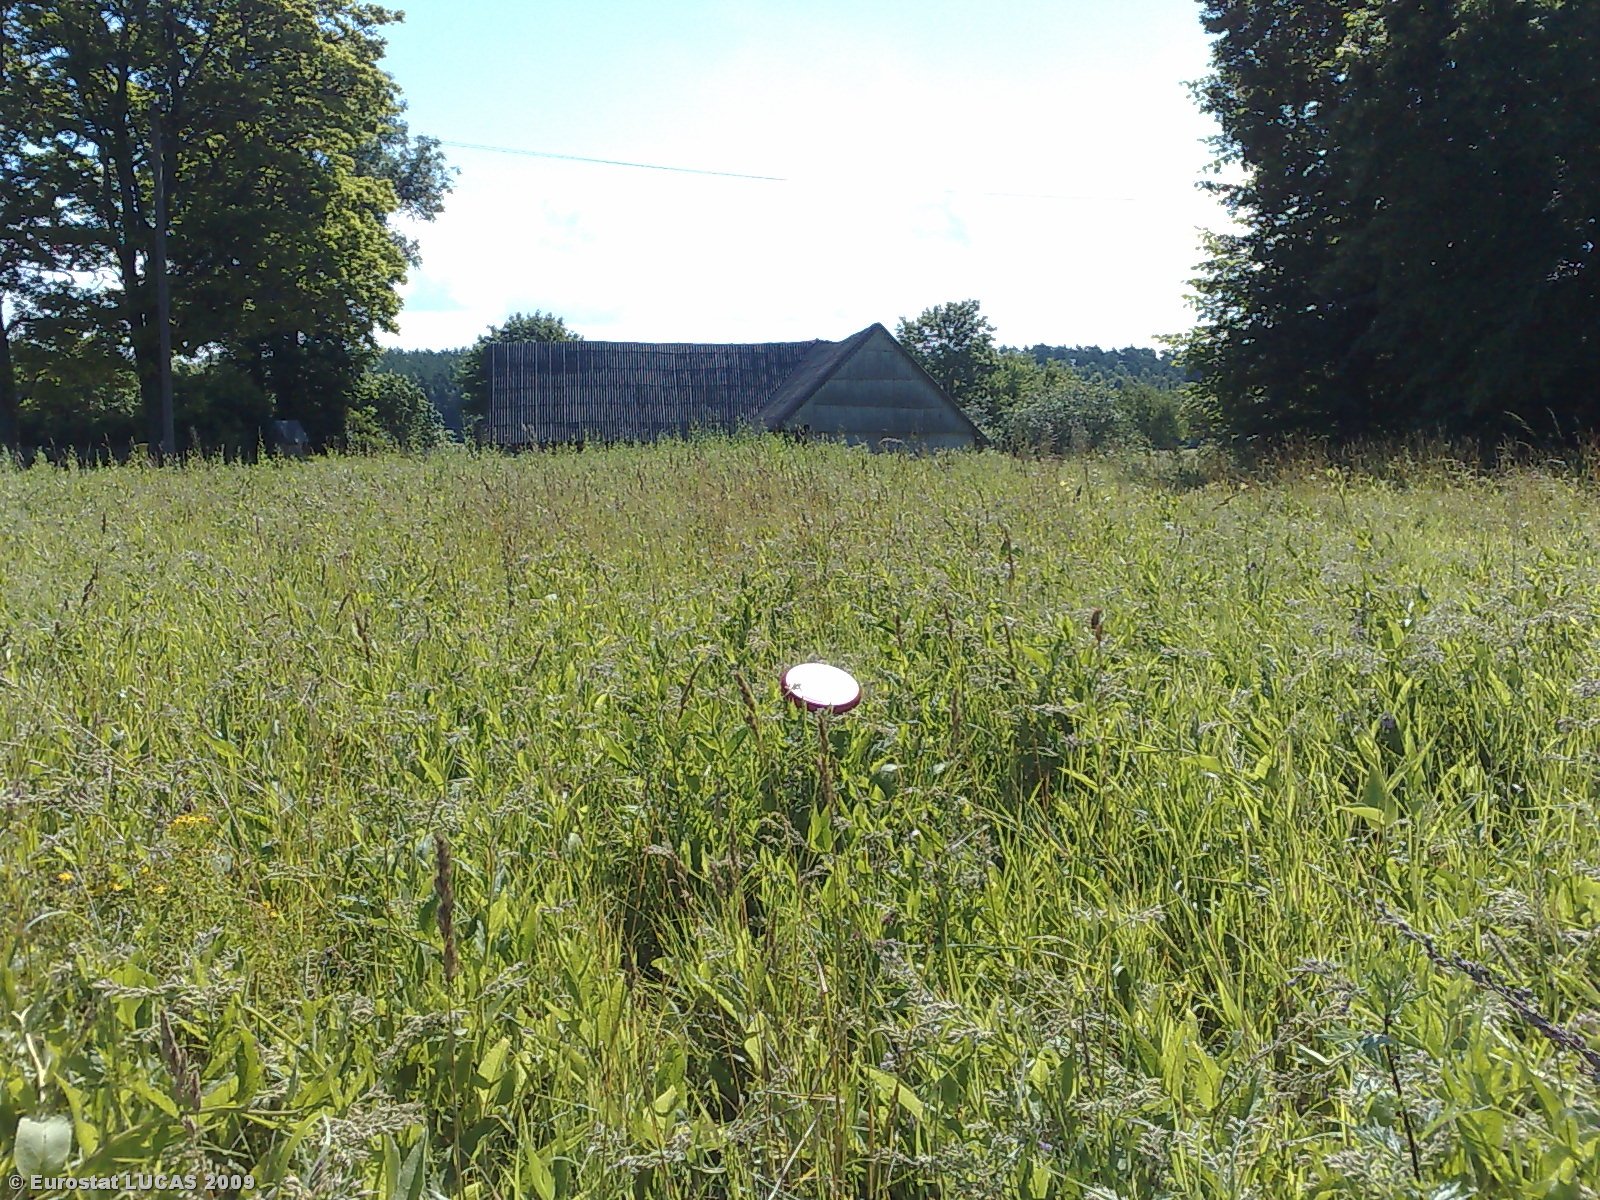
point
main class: Grassland
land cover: Grassland without tree/shrub cover
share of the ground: > 75 %
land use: Agriculture (excluding fallow land and kitchen gardens)
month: July
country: LT
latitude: 55.9001
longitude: 22.8768
